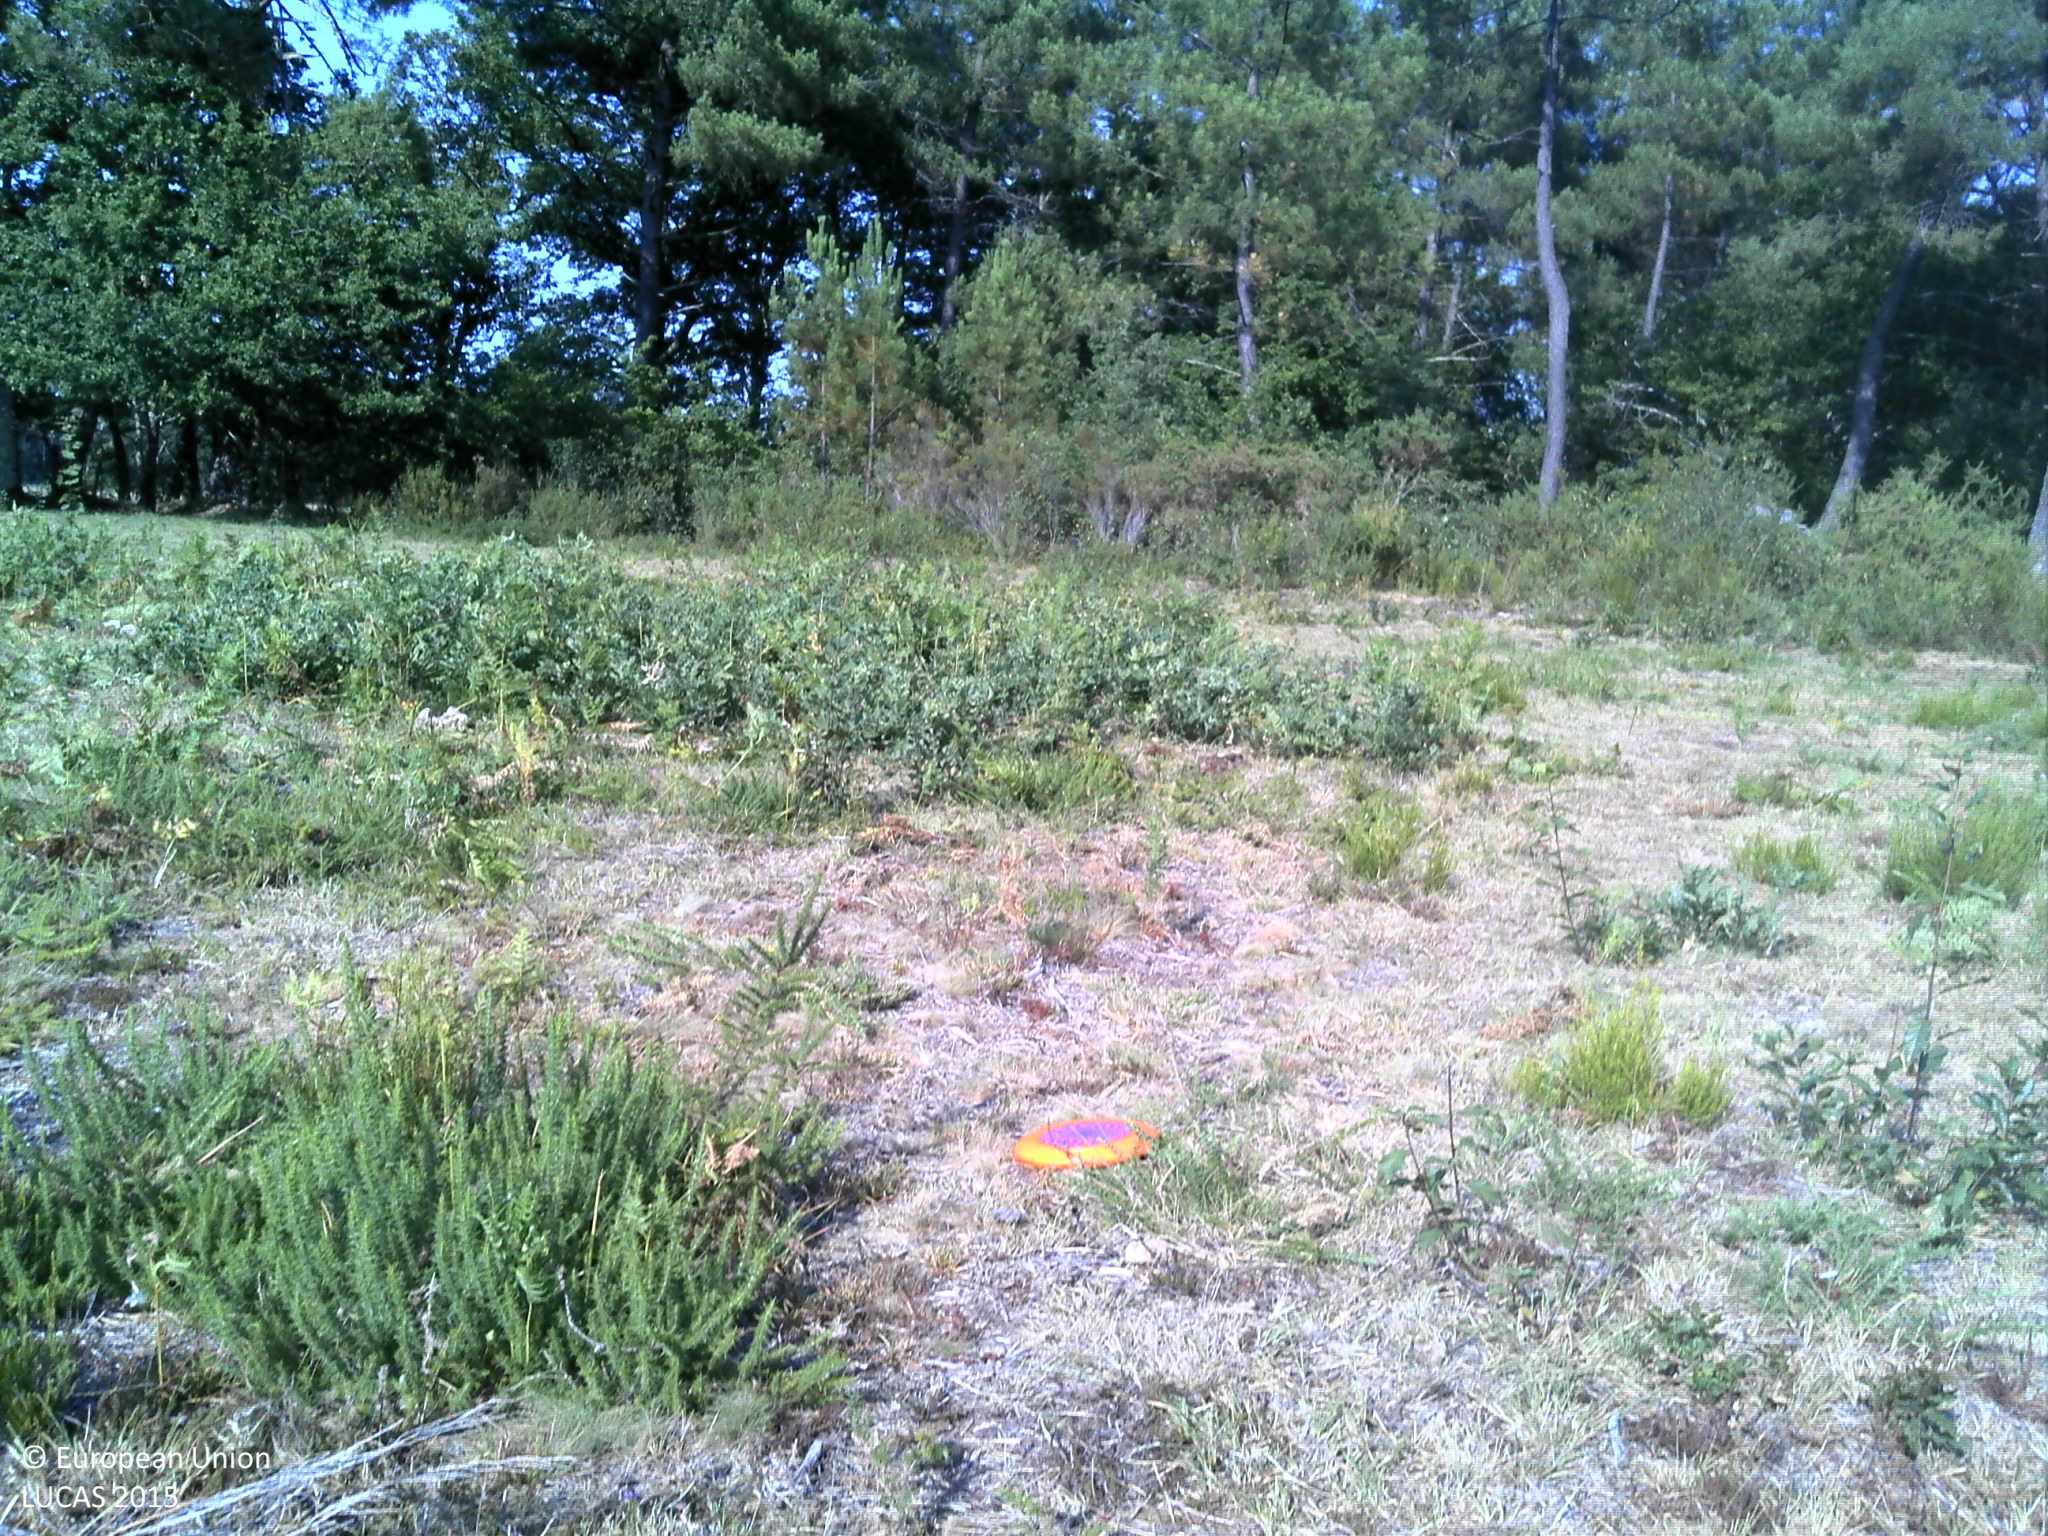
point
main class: Grassland
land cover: Spontaneously vegetated surfaces
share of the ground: > 75 %
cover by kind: herbaceous plants 95 %, shrubs 5 %
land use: Semi-natural and natural areas not in use
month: July
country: FR
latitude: 44.5840
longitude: -0.4572
